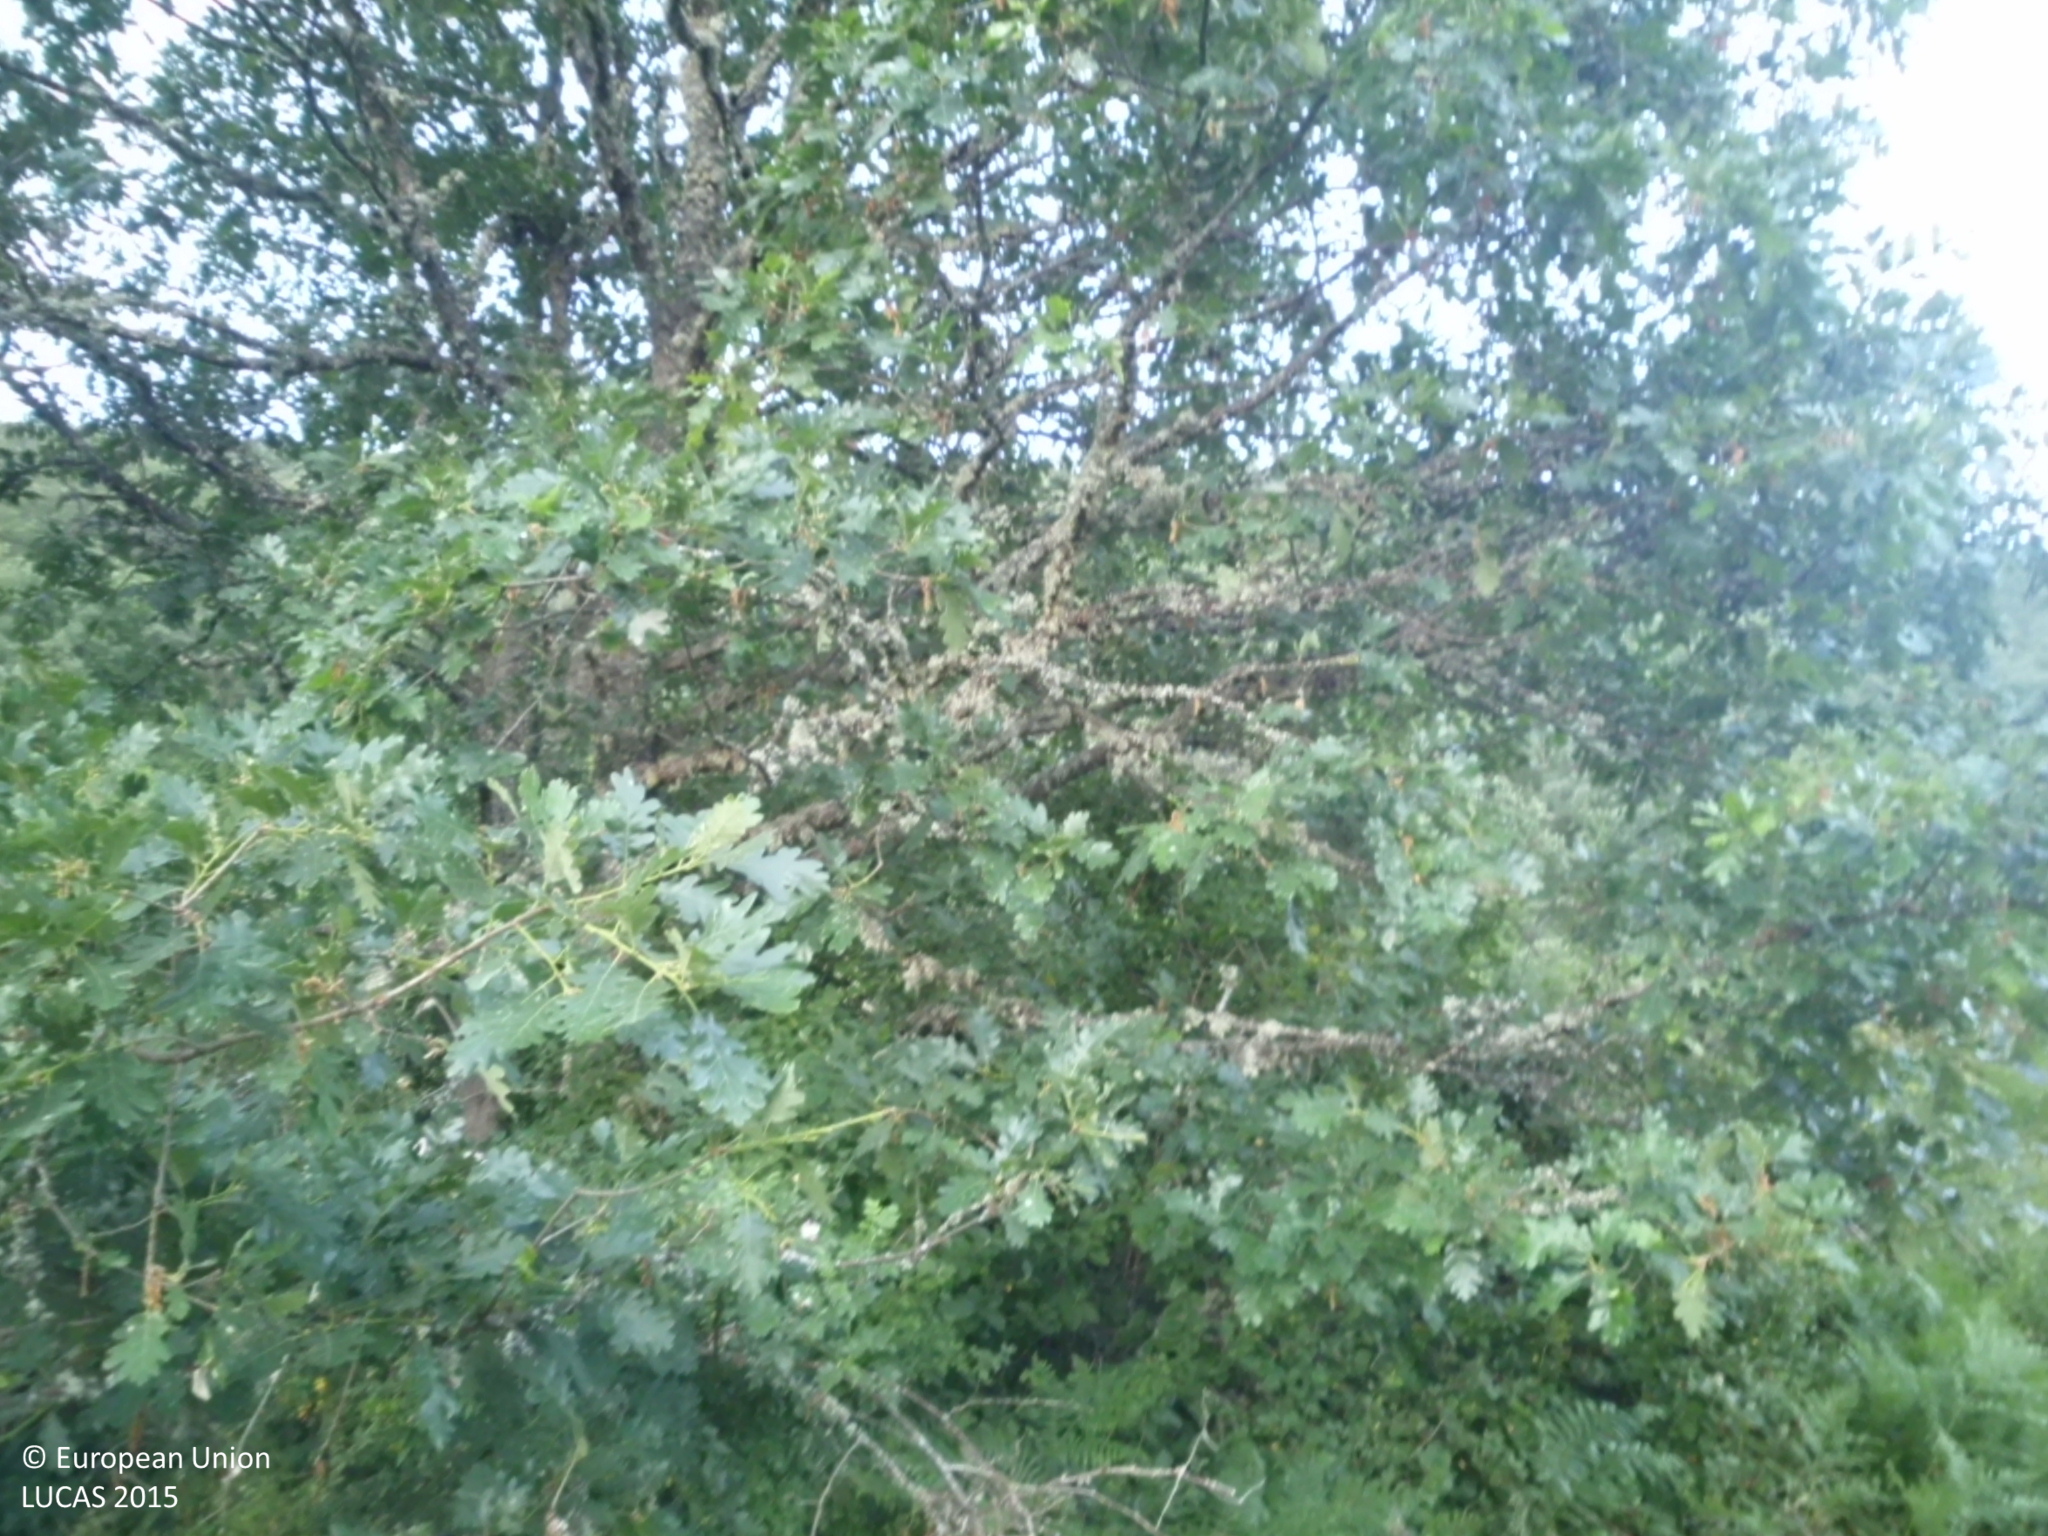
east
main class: Grassland
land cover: Grassland without tree/shrub cover
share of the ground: > 75 %
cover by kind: herbaceous plants 95 %, shrubs 5 %
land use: Abandoned areas
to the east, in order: Grassland without tree/shrub cover; Abandoned hedges; Grassland without tree/shrub cover; Broadleaved woodland
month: June
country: ES
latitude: 42.8384
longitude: -4.9528
